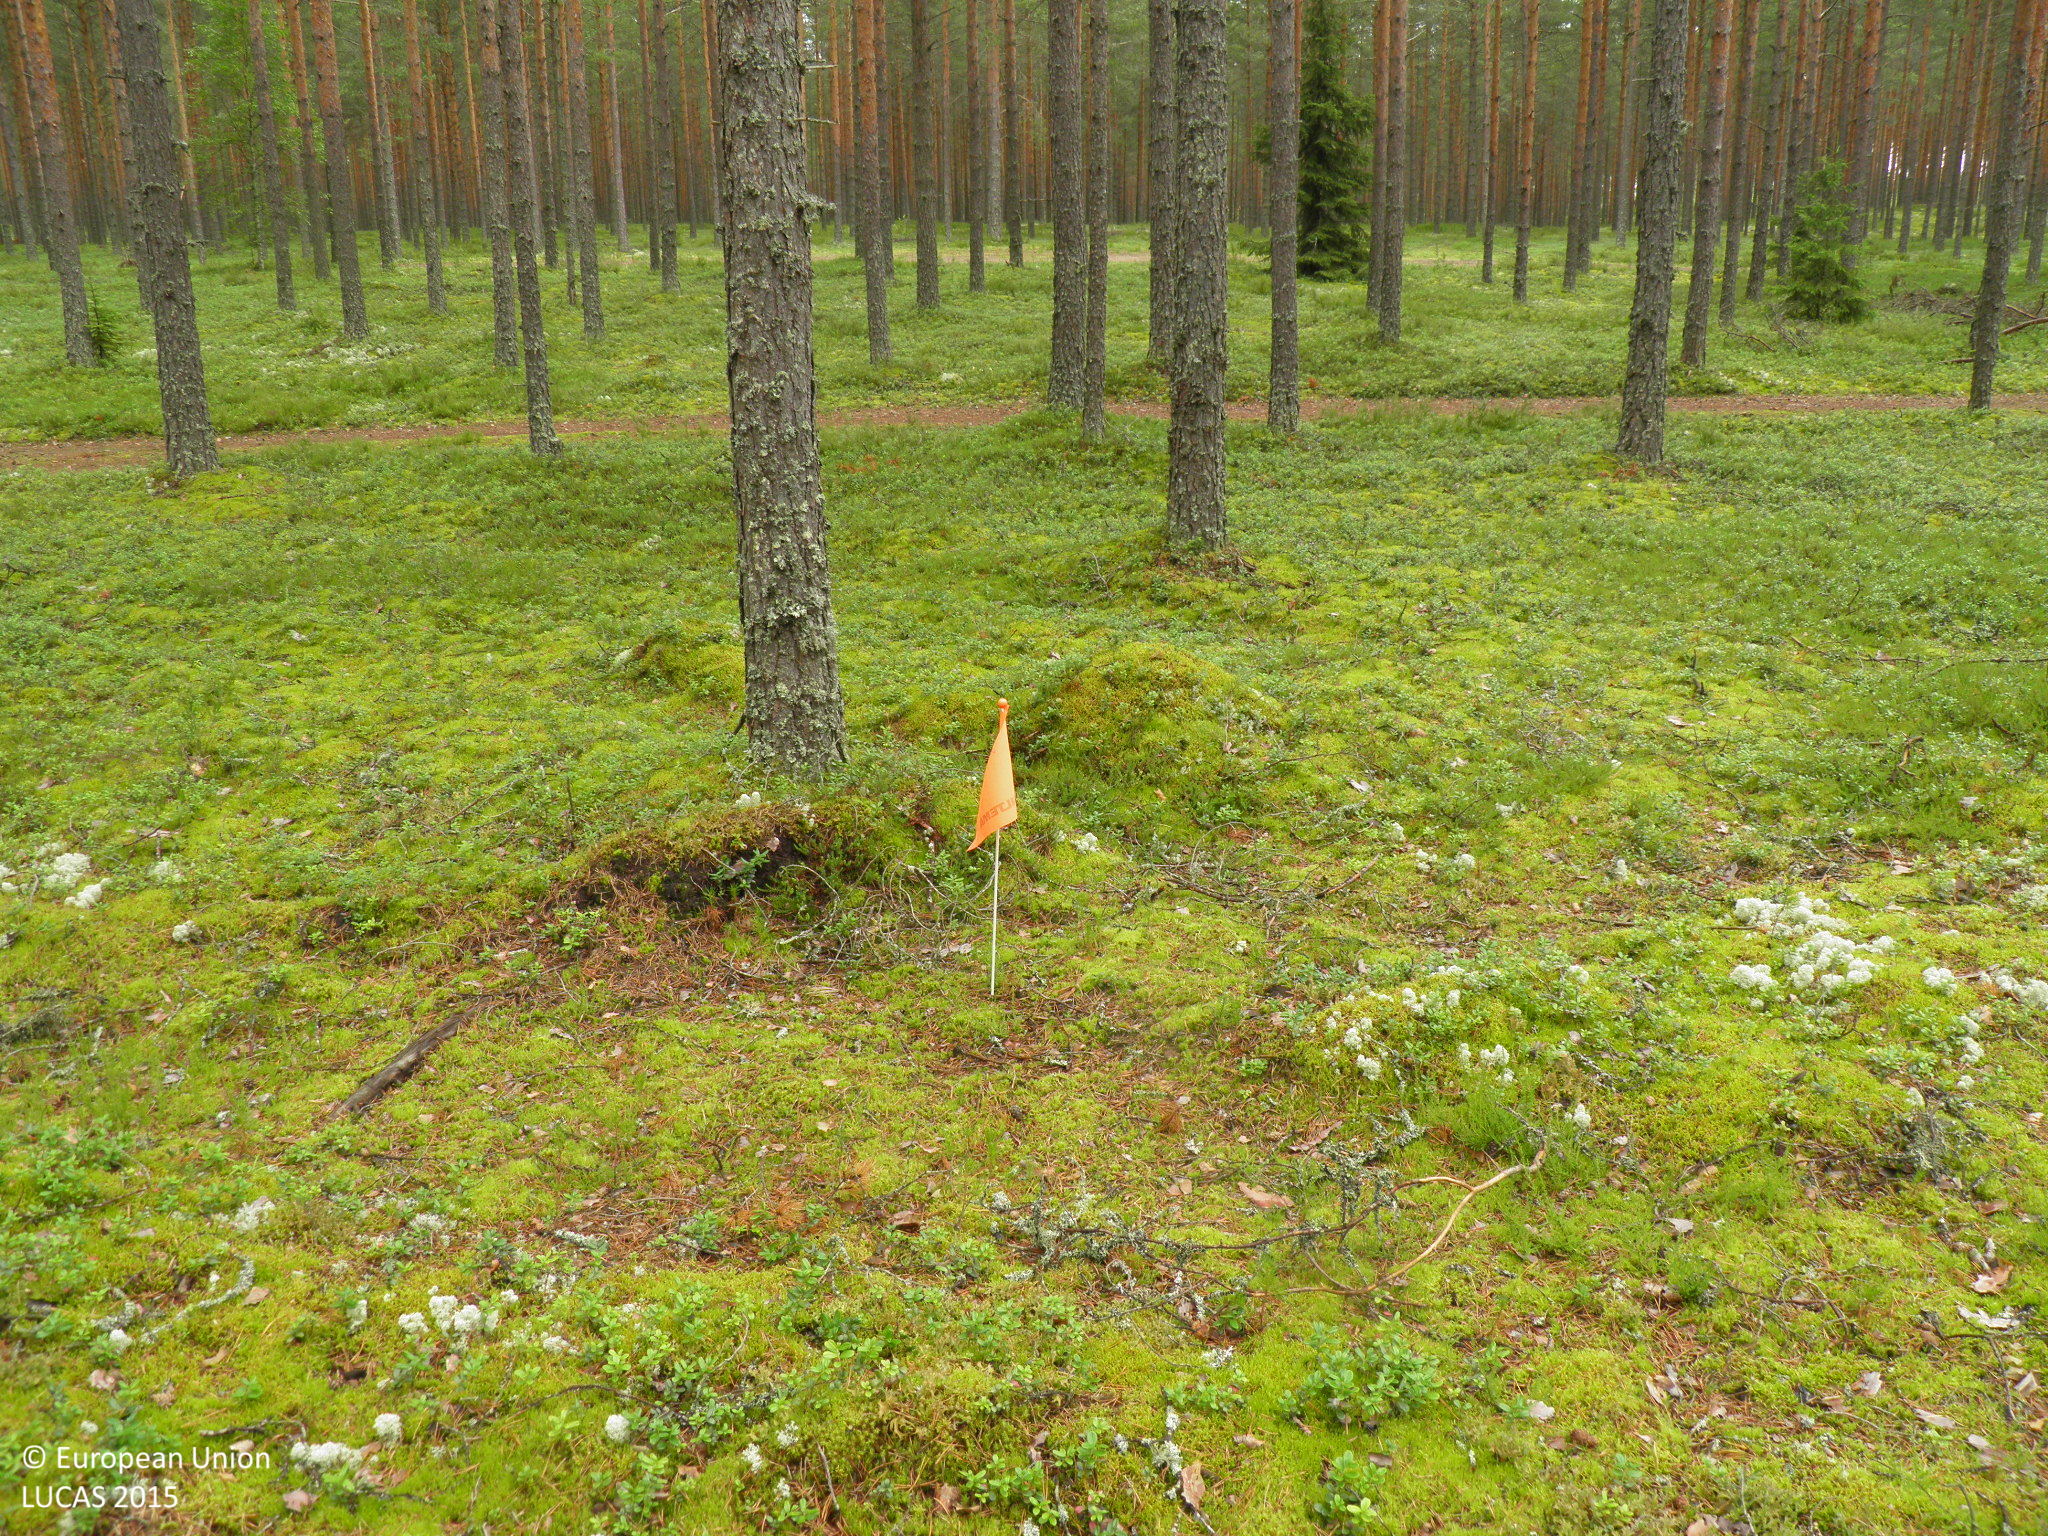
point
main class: Woodland
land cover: Pine dominated coniferous woodland
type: hemiboreal forest and nemoral coniferous forest and mixed broadleaved-coniferous forest
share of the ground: 50 - 75 %
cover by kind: coniferous forest trees 60 %, lichens and mosses 30 %, shrubs 10 %
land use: Forestry
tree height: > 5 m
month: July
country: FI
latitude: 60.8805
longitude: 22.7269
